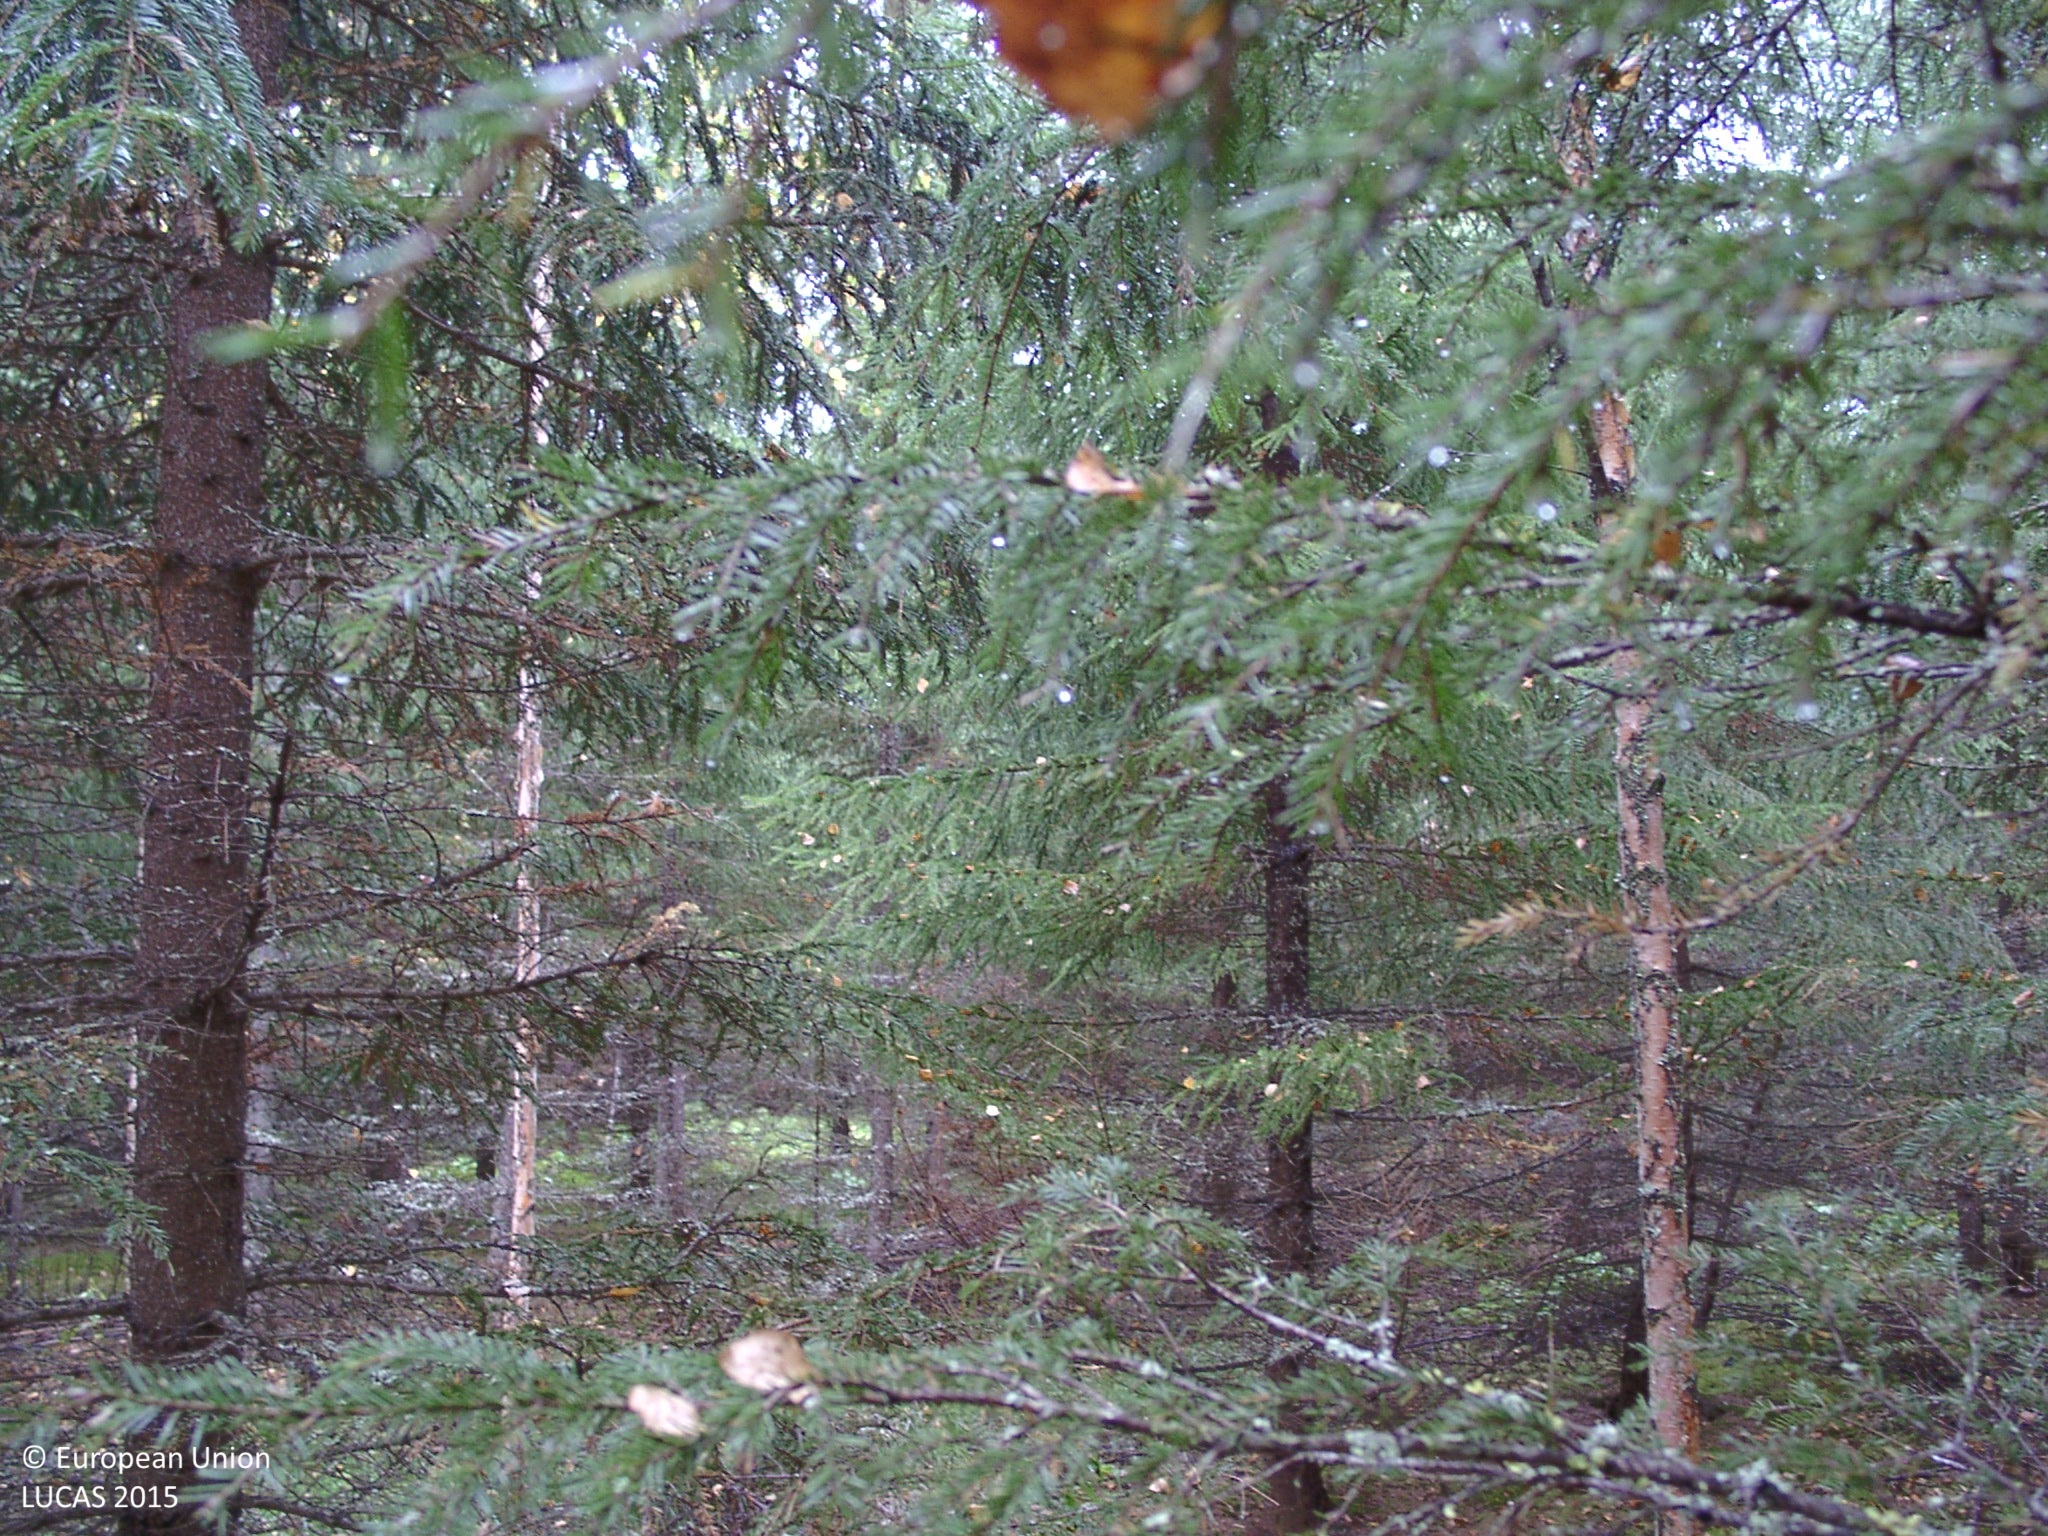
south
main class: Woodland
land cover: Spruce dominated mixed woodland
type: boreal forest
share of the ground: > 75 %
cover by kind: coniferous forest trees 60 %, broadleaved forest trees 25 %, herbaceous plants 5 %, lichens and mosses 5 %
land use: Forestry
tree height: > 5 m
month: September
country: FI
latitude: 62.6211
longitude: 25.6090
